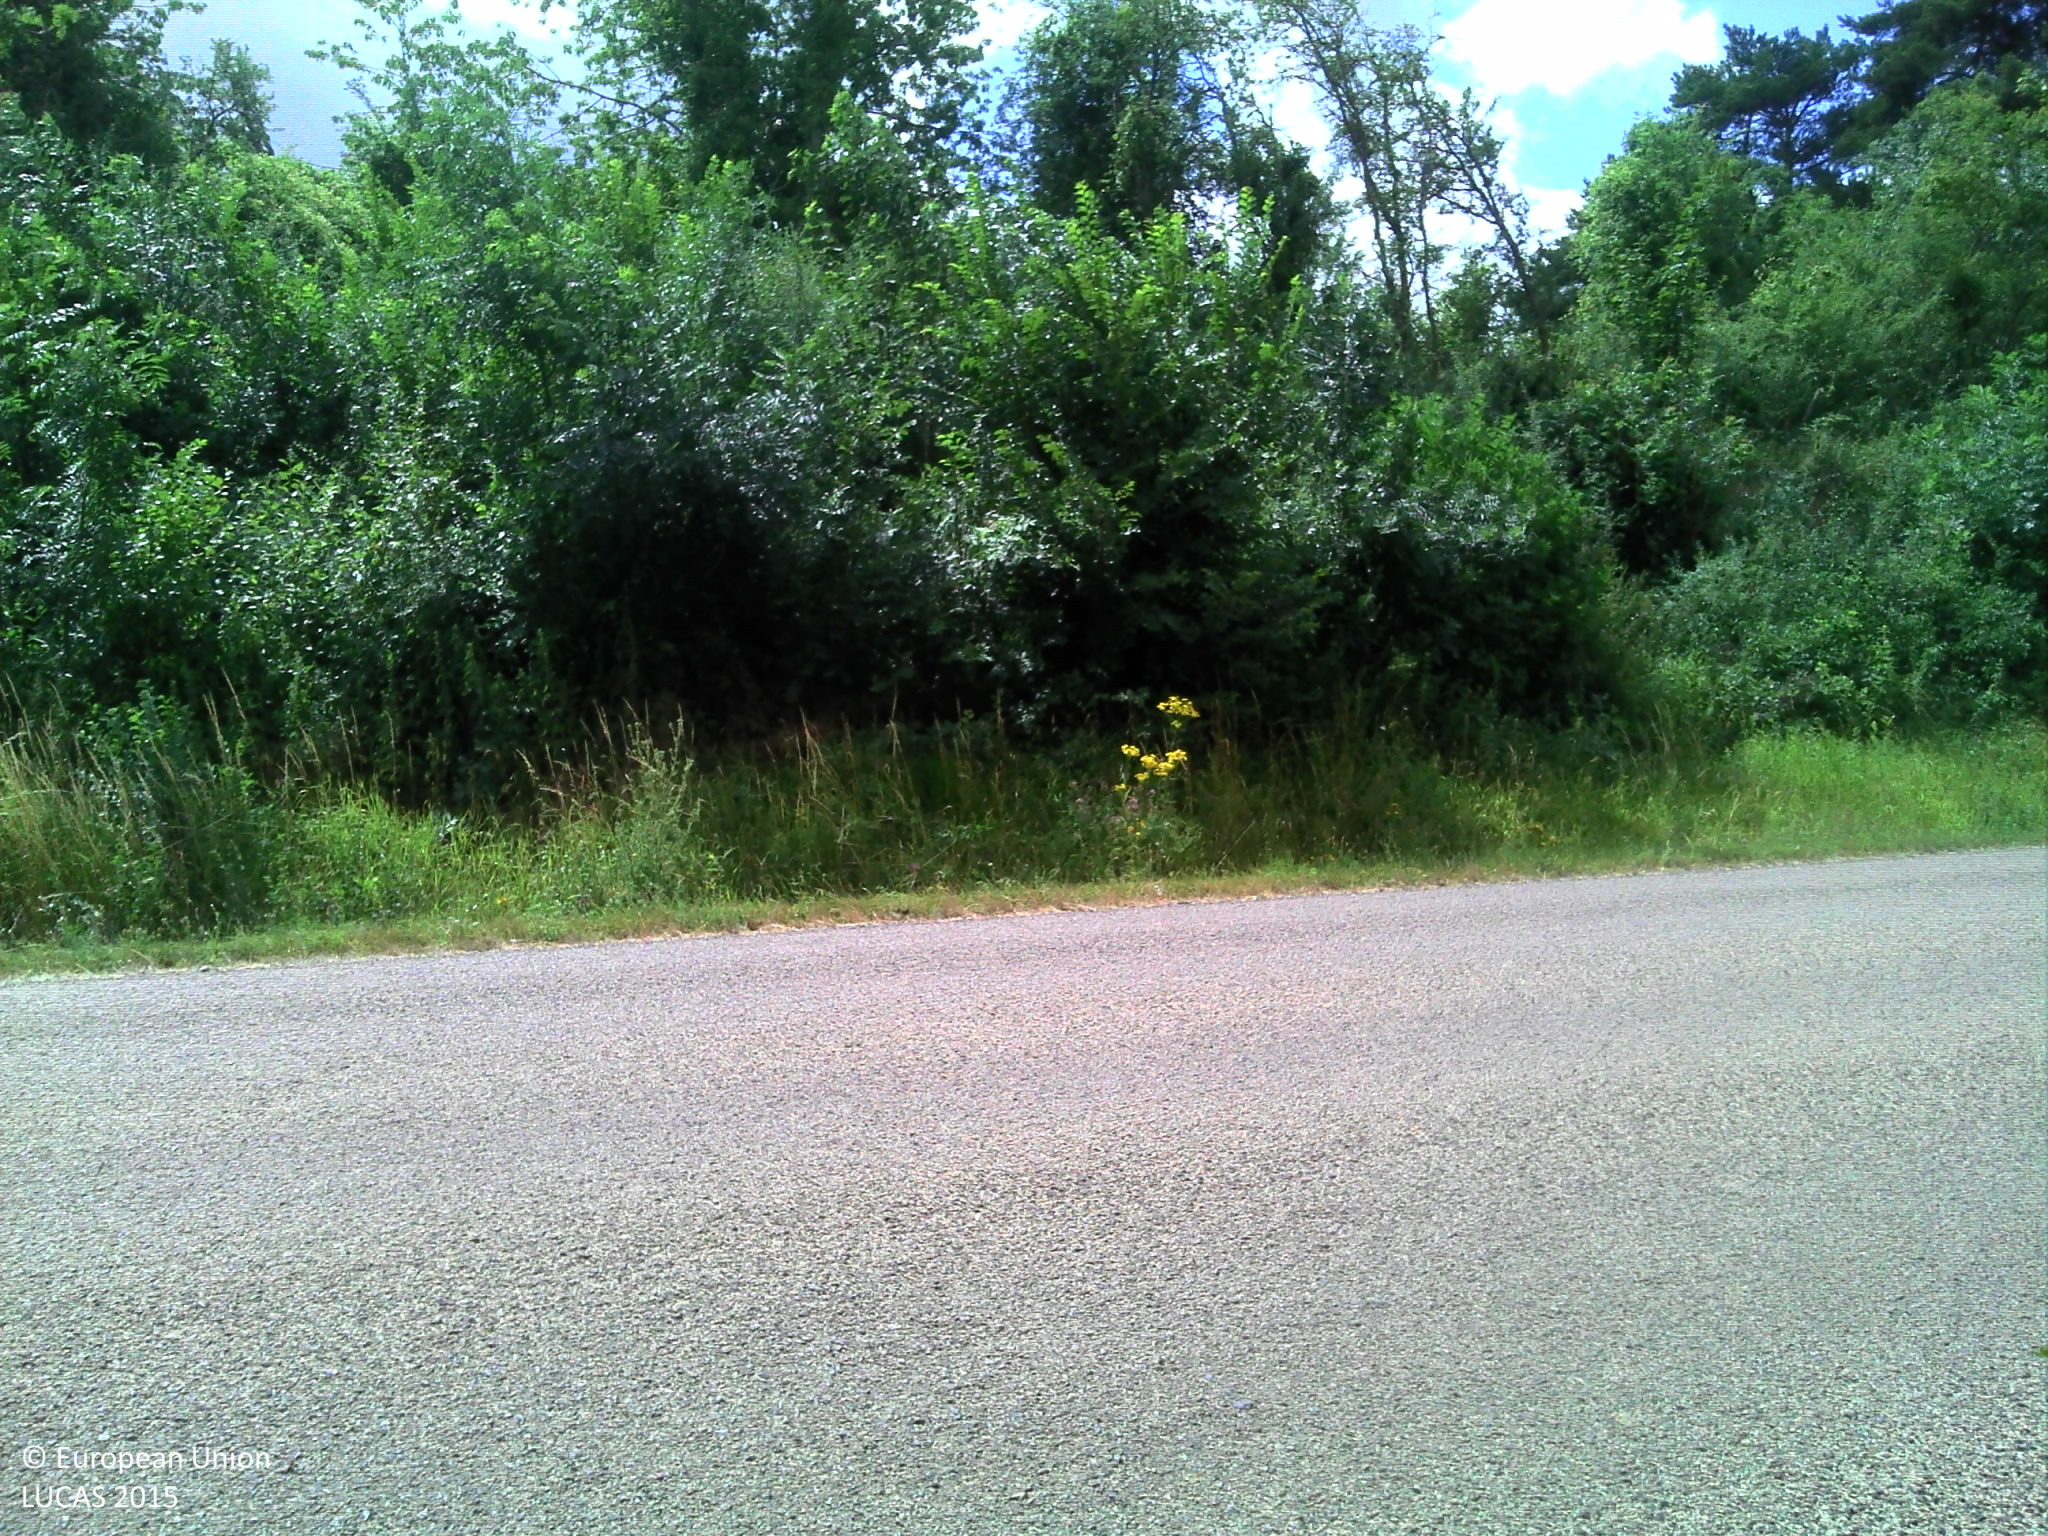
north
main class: Grassland
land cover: Grassland with sparse tree/shrub cover
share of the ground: > 75 %
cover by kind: herbaceous plants 90 %, broadleaved forest trees 5 %, shrubs 5 %
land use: Agriculture (excluding fallow land and kitchen gardens)
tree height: > 5 m
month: July
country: FR
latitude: 48.2967
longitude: 3.4023
